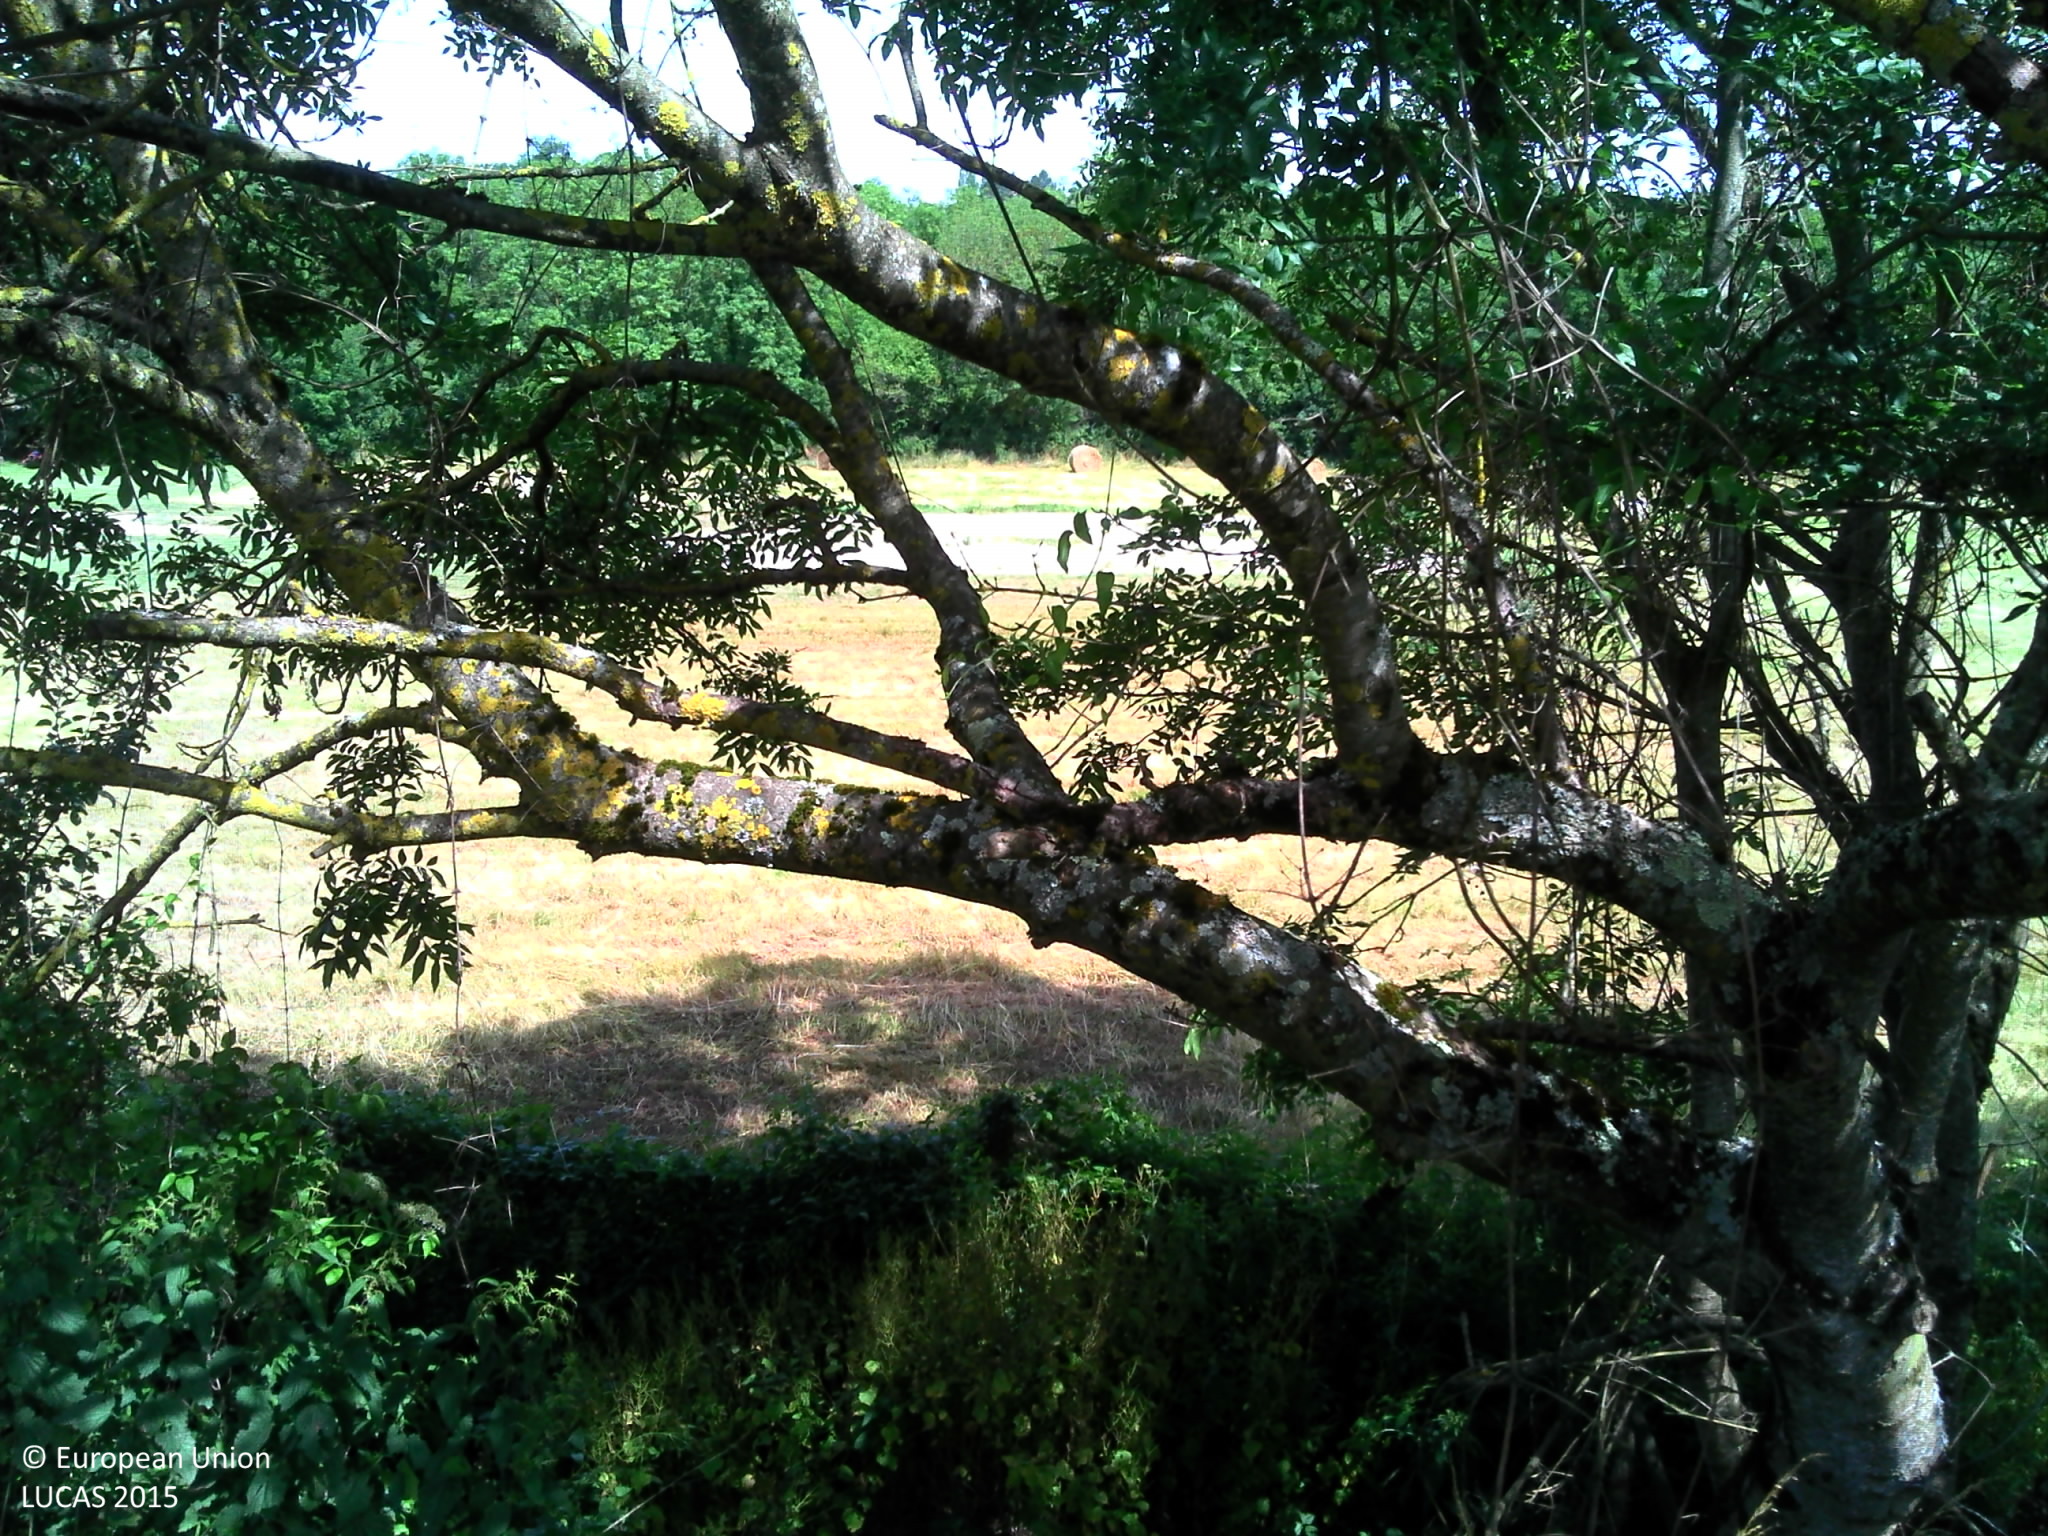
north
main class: Grassland
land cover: Grassland without tree/shrub cover
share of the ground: > 75 %
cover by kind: herbaceous plants 100 %
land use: Community services
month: June
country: FR
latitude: 47.4545
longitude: 3.5104
